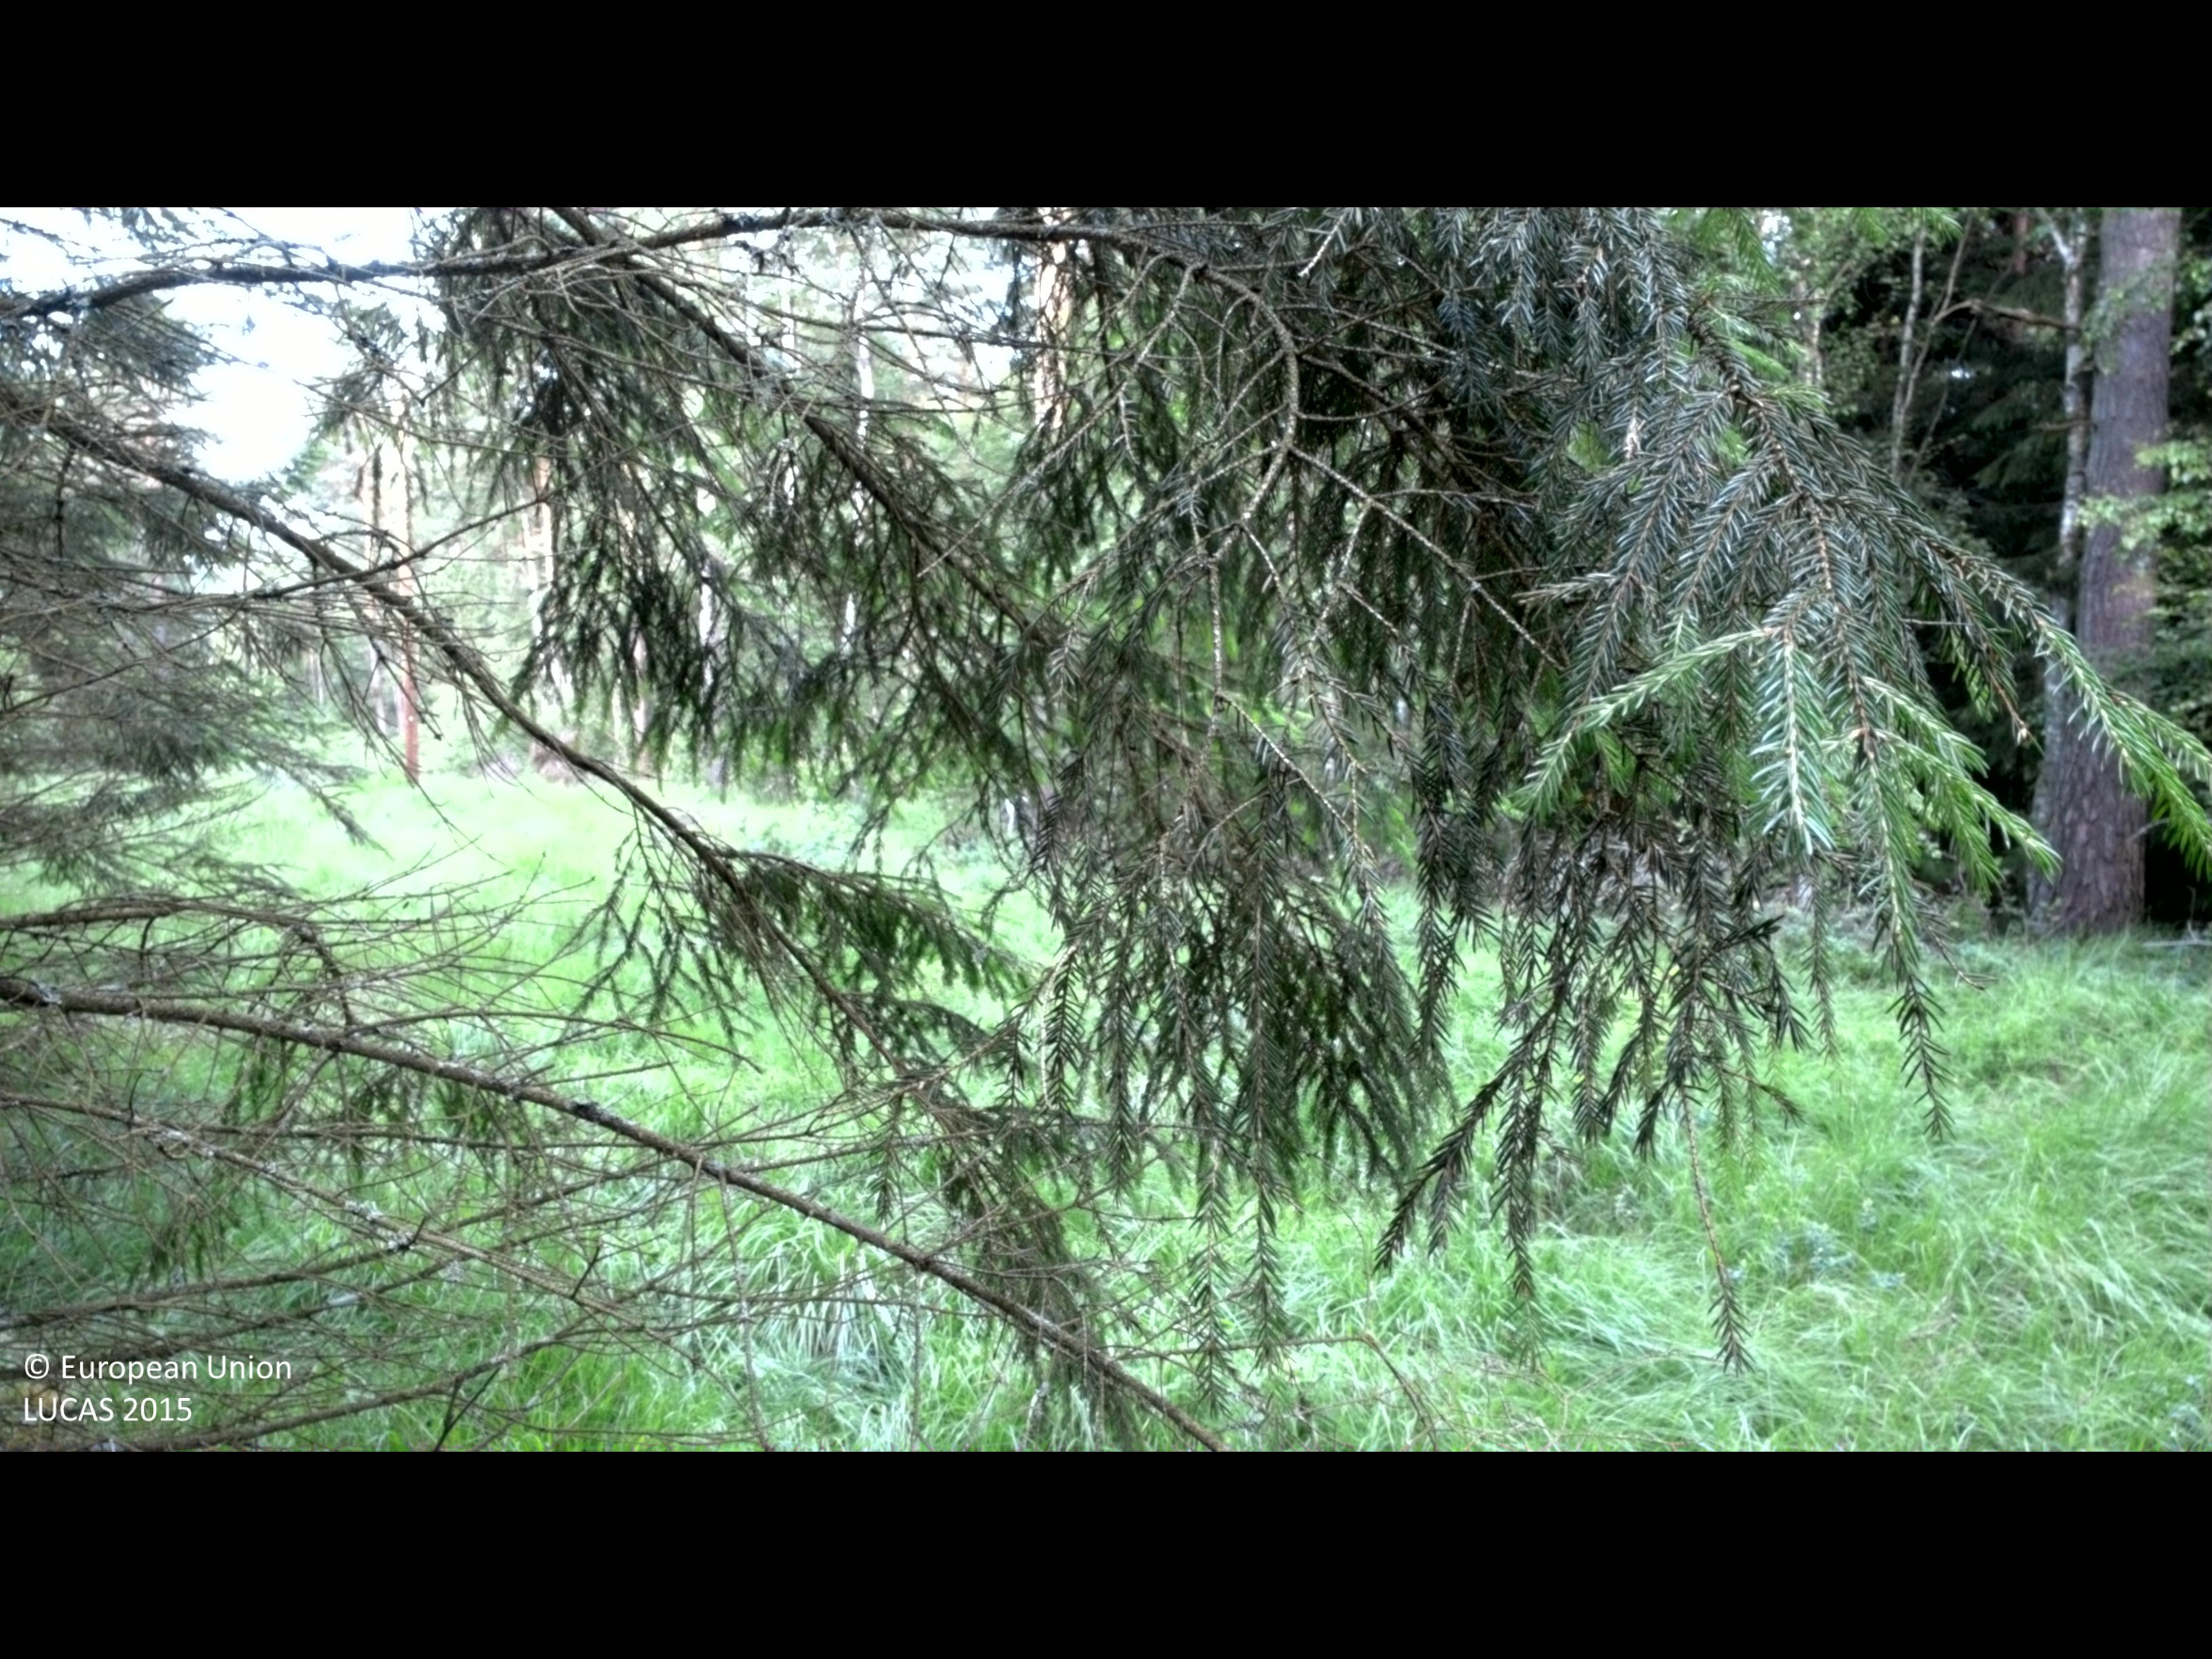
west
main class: Woodland
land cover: Spruce dominated coniferous woodland
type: boreal forest
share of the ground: > 75 %
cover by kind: coniferous forest trees 75 %, lichens and mosses 20 %
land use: Forestry
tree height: > 5 m
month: August
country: SE
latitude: 56.6527
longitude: 13.8299
